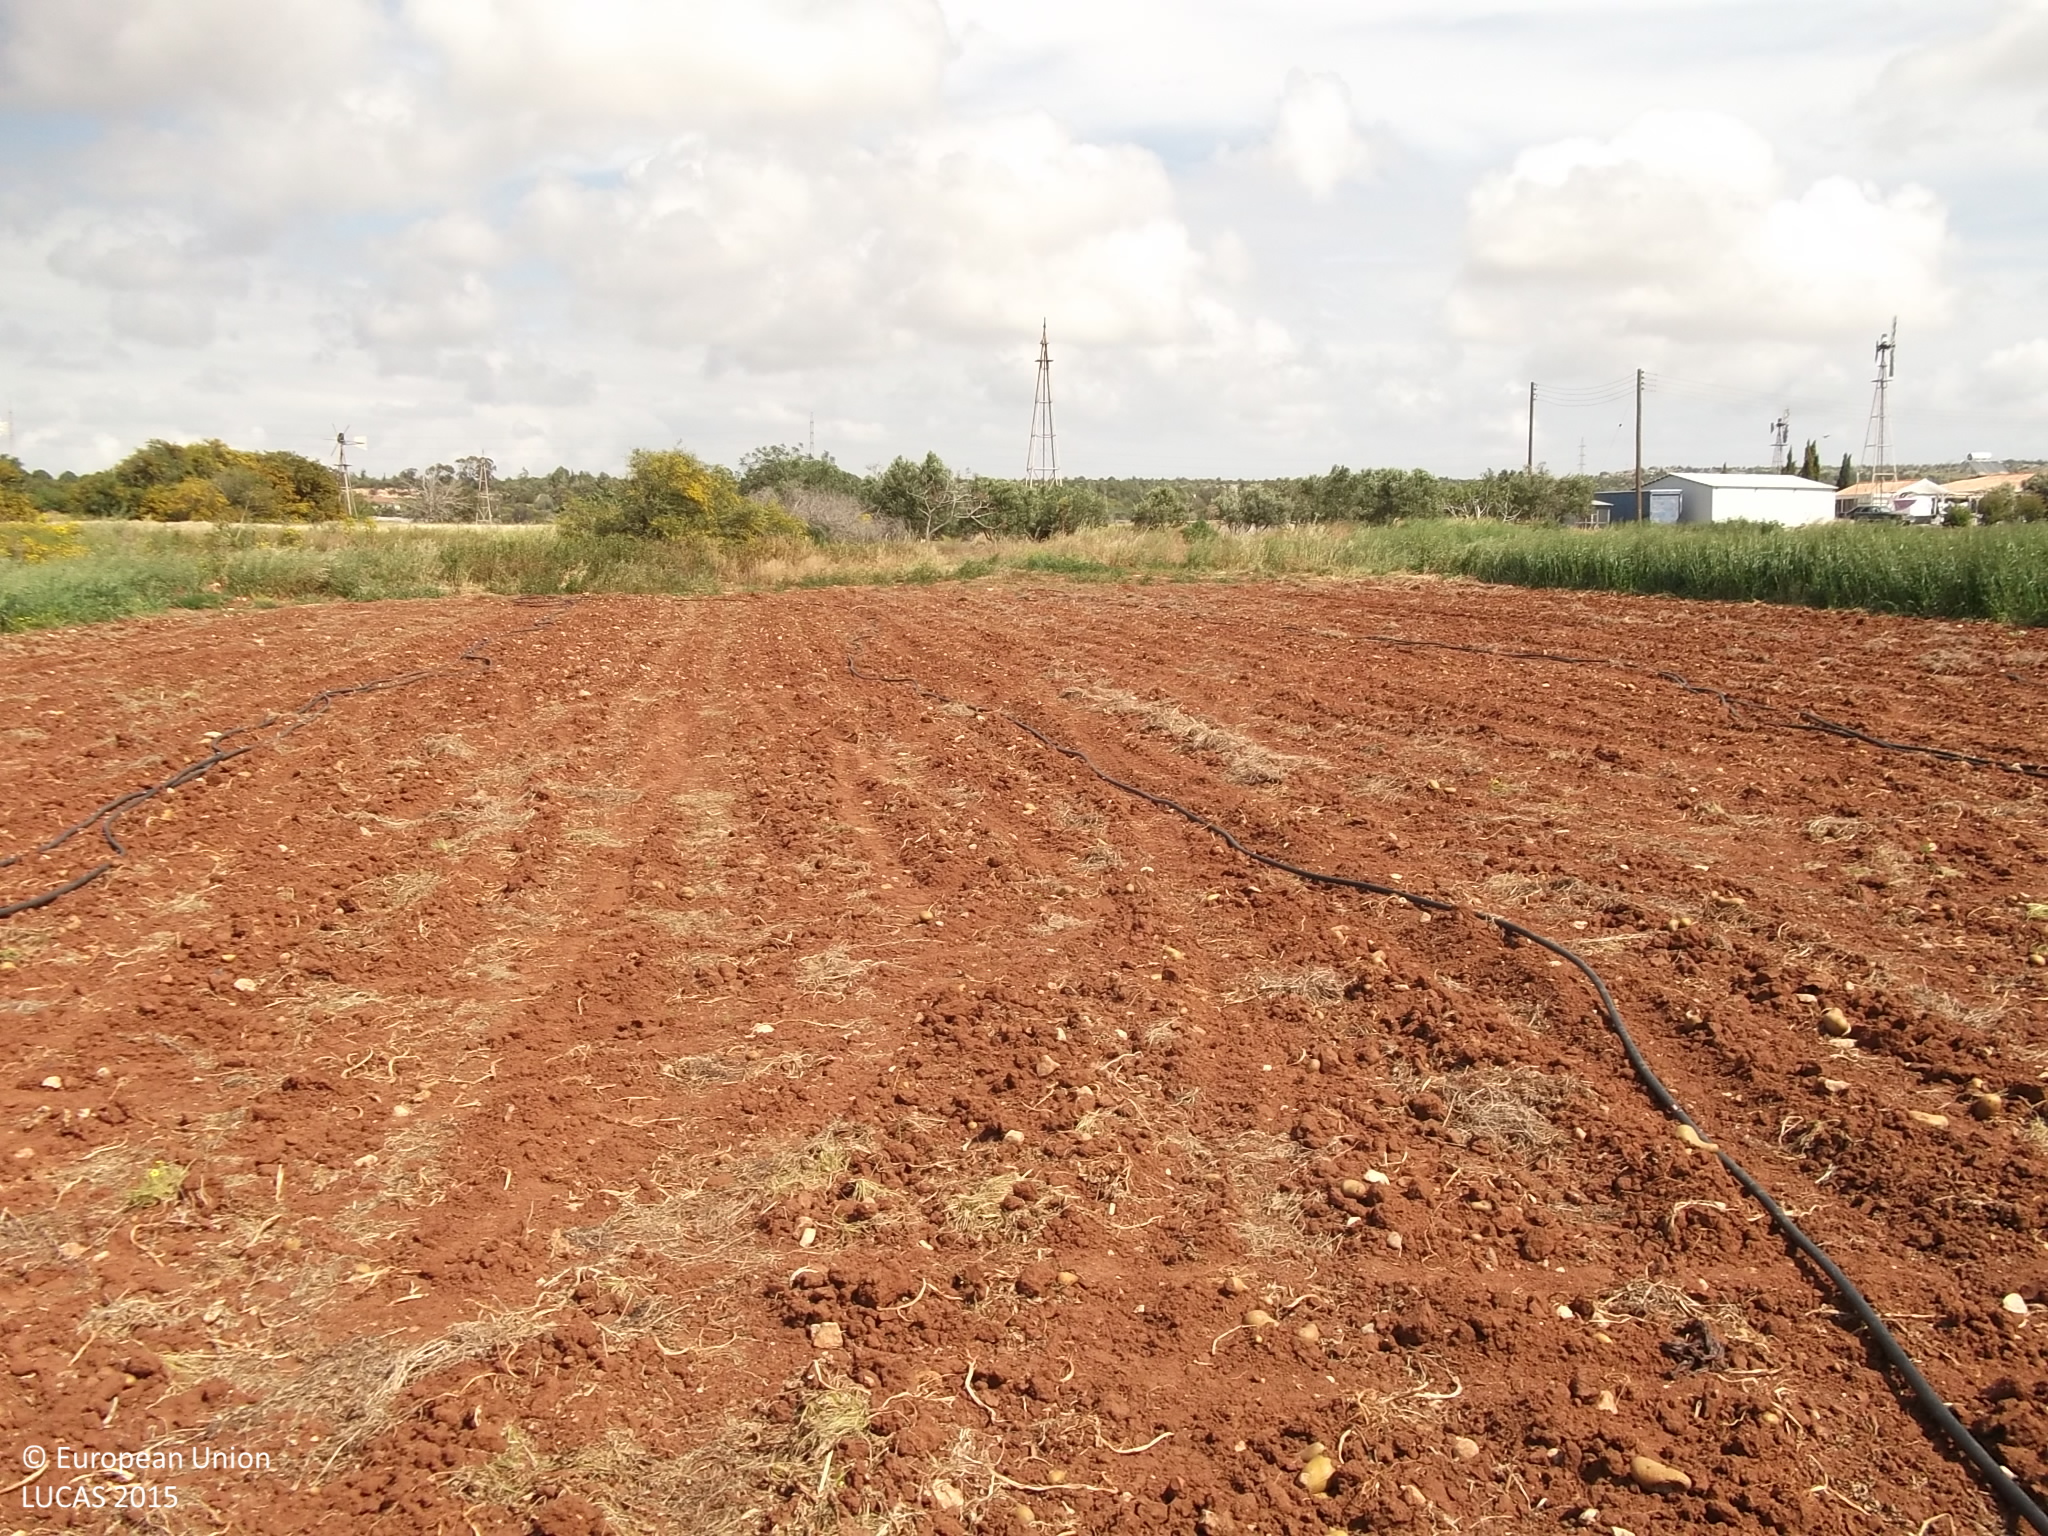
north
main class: Cropland
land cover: Potatoes
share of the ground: < 10 %
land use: Agriculture (excluding fallow land and kitchen gardens)
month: March
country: CY
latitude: 34.9953
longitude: 33.9549
